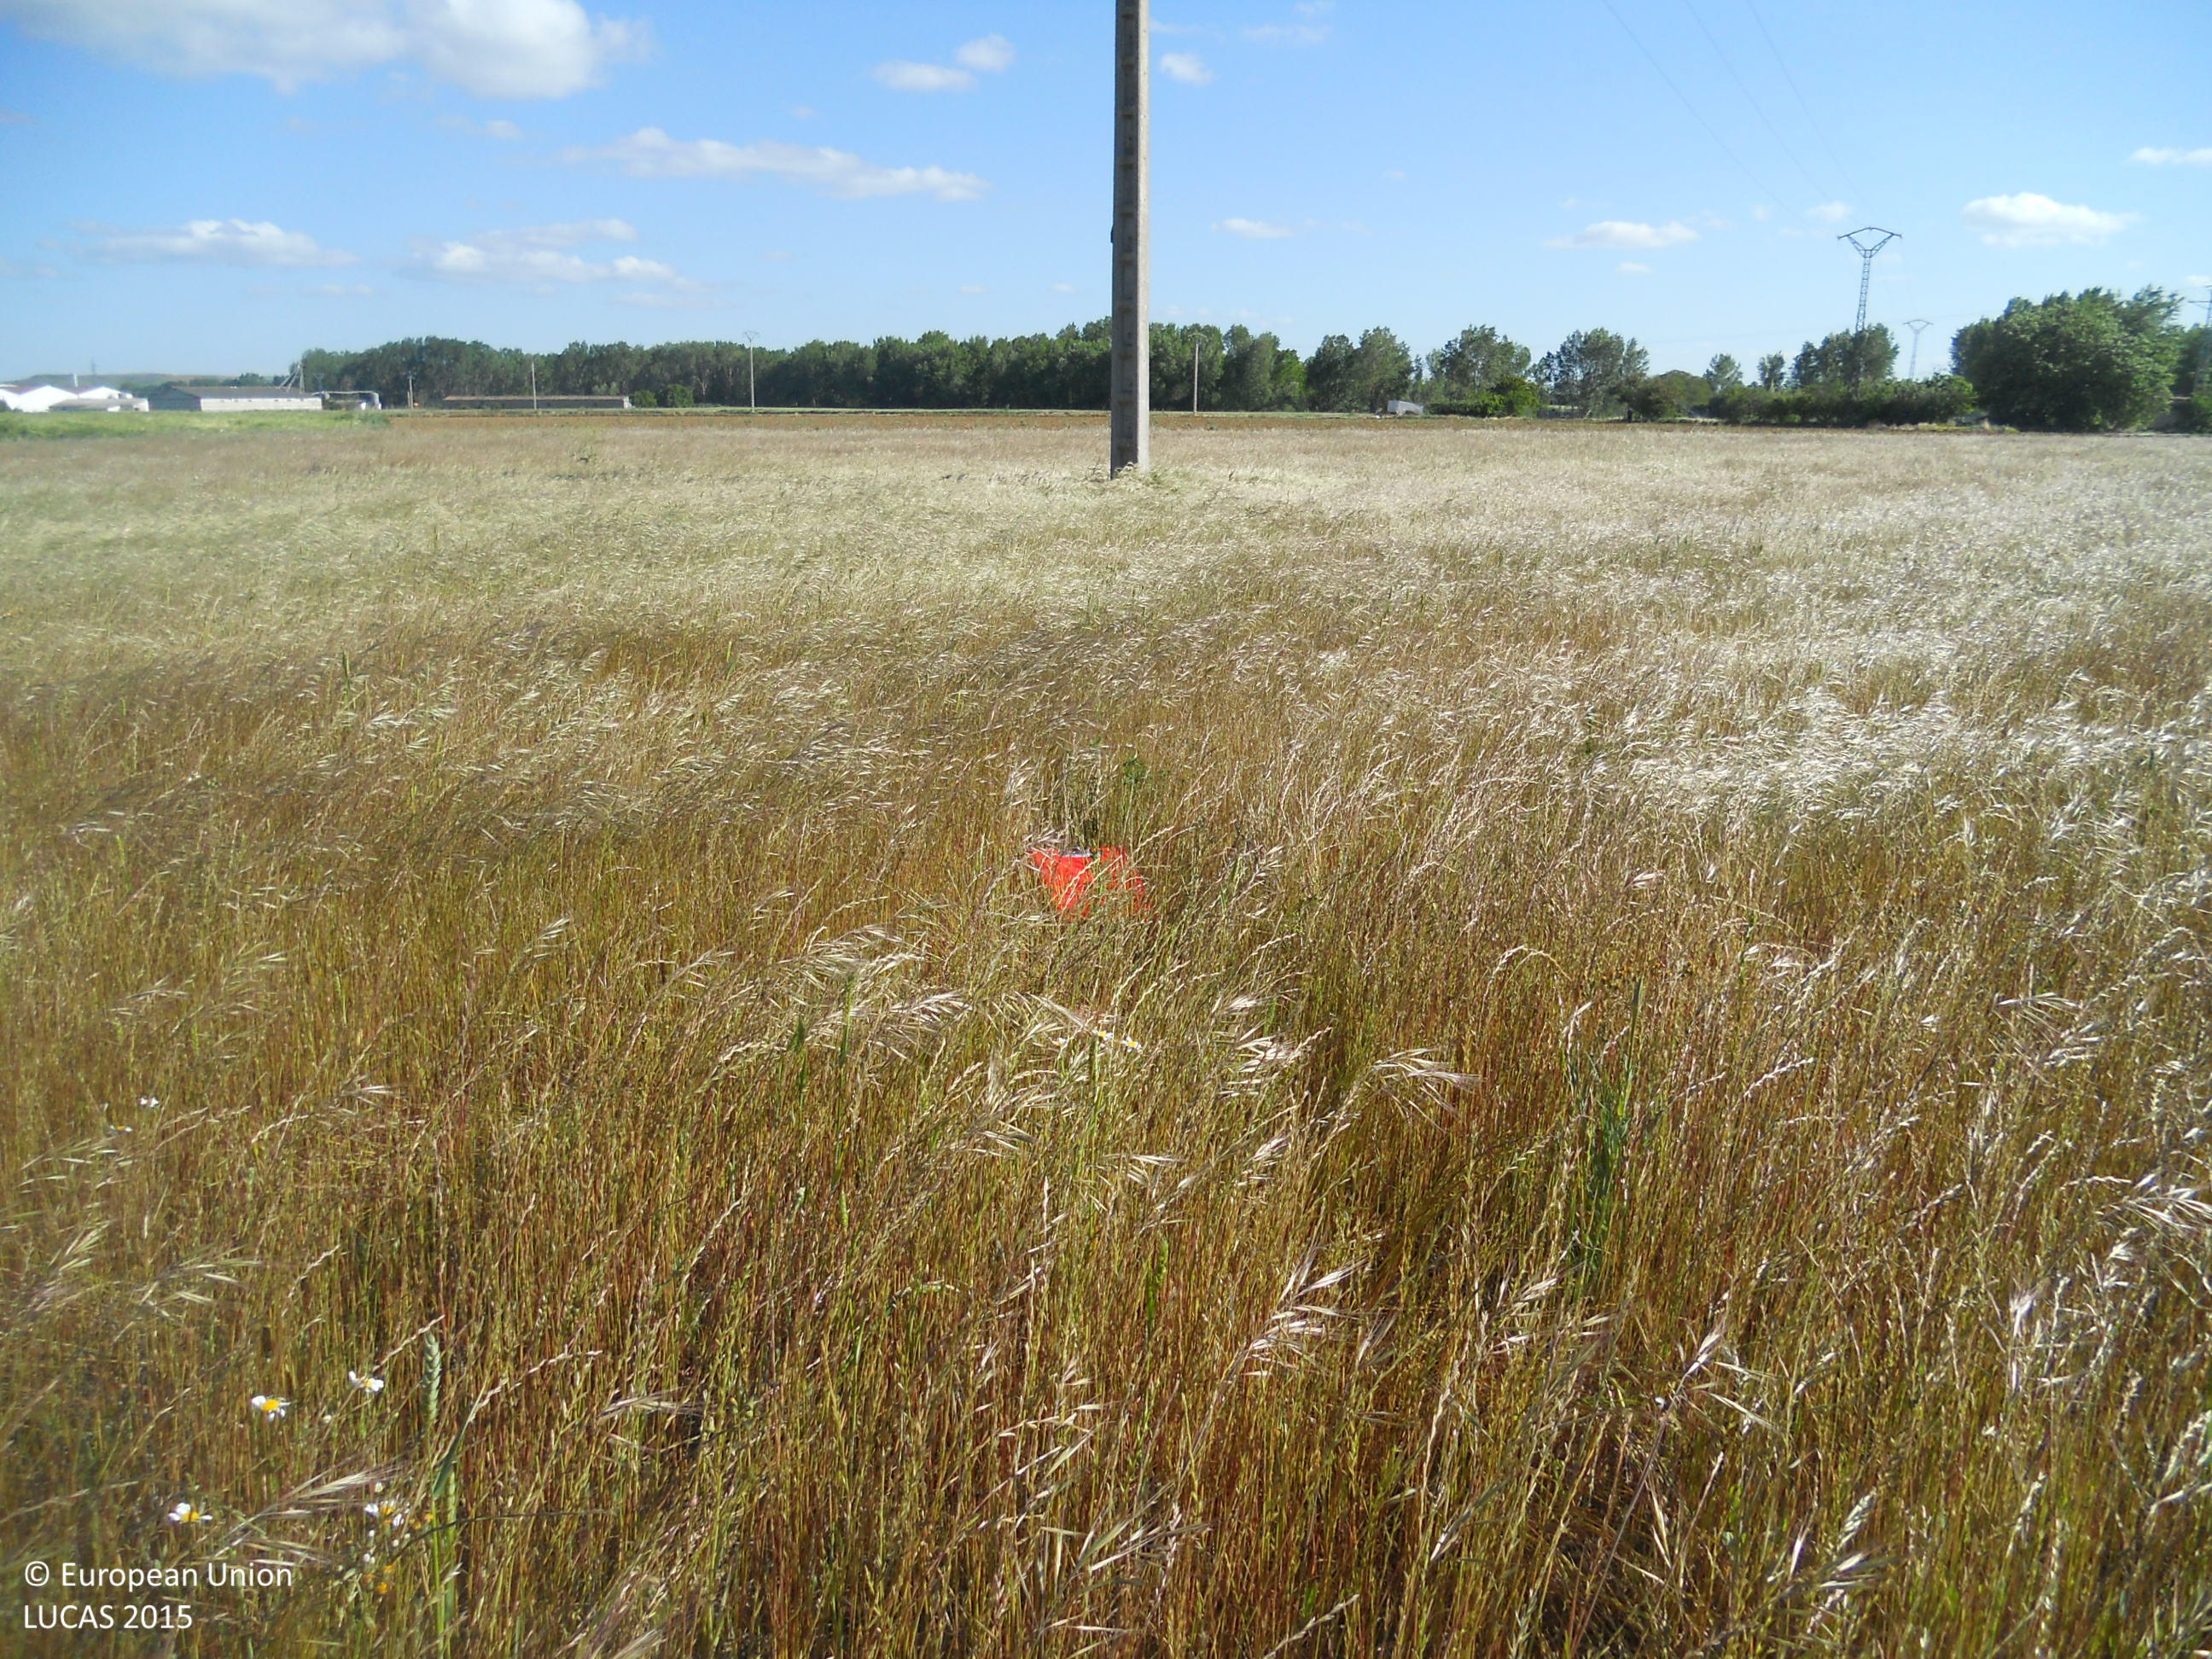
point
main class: Grassland
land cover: Spontaneously vegetated surfaces
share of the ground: > 75 %
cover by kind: herbaceous plants 100 %
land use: Fallow land
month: May
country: ES
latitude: 42.4313
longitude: -4.3545
